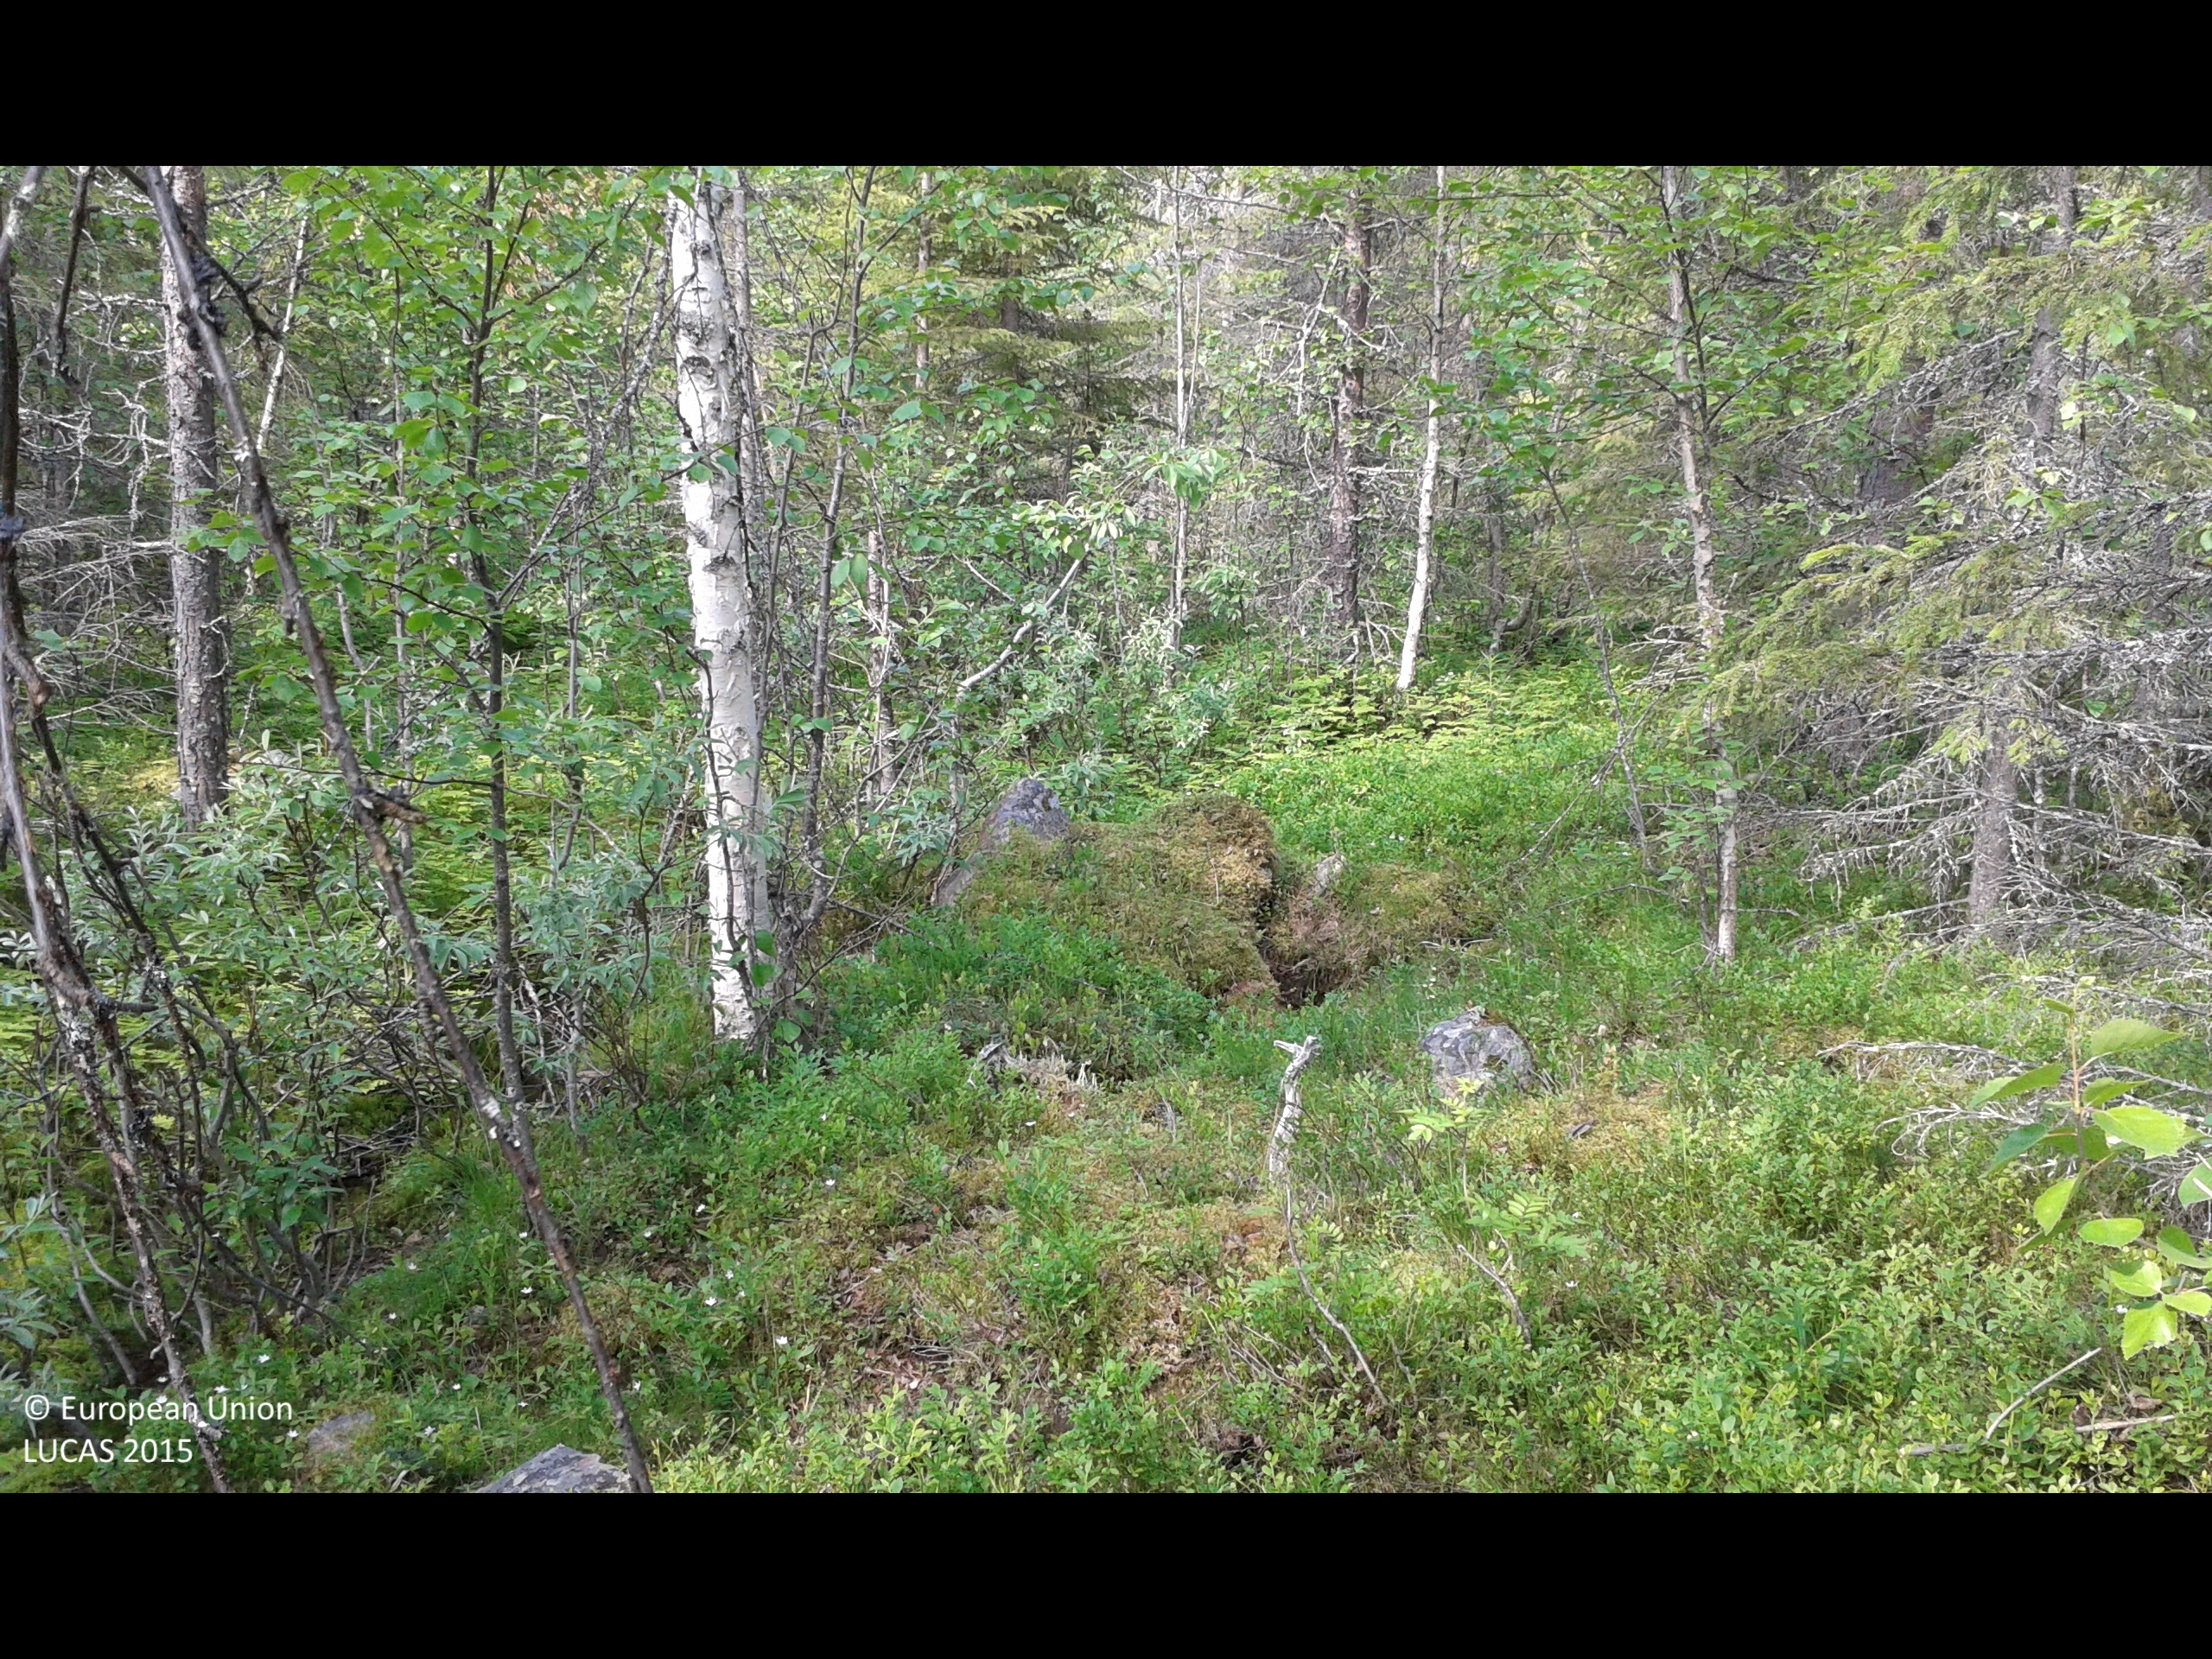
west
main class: Woodland
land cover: Pine dominated mixed woodland
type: boreal forest
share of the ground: 25 - 50 %
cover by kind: shrubs 50 %, coniferous forest trees 20 %, herbaceous plants 15 %, broadleaved forest trees 10 %, lichens and mosses 5 %
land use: Forestry
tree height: > 5 m
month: July
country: SE
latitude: 66.7492
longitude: 23.4413
